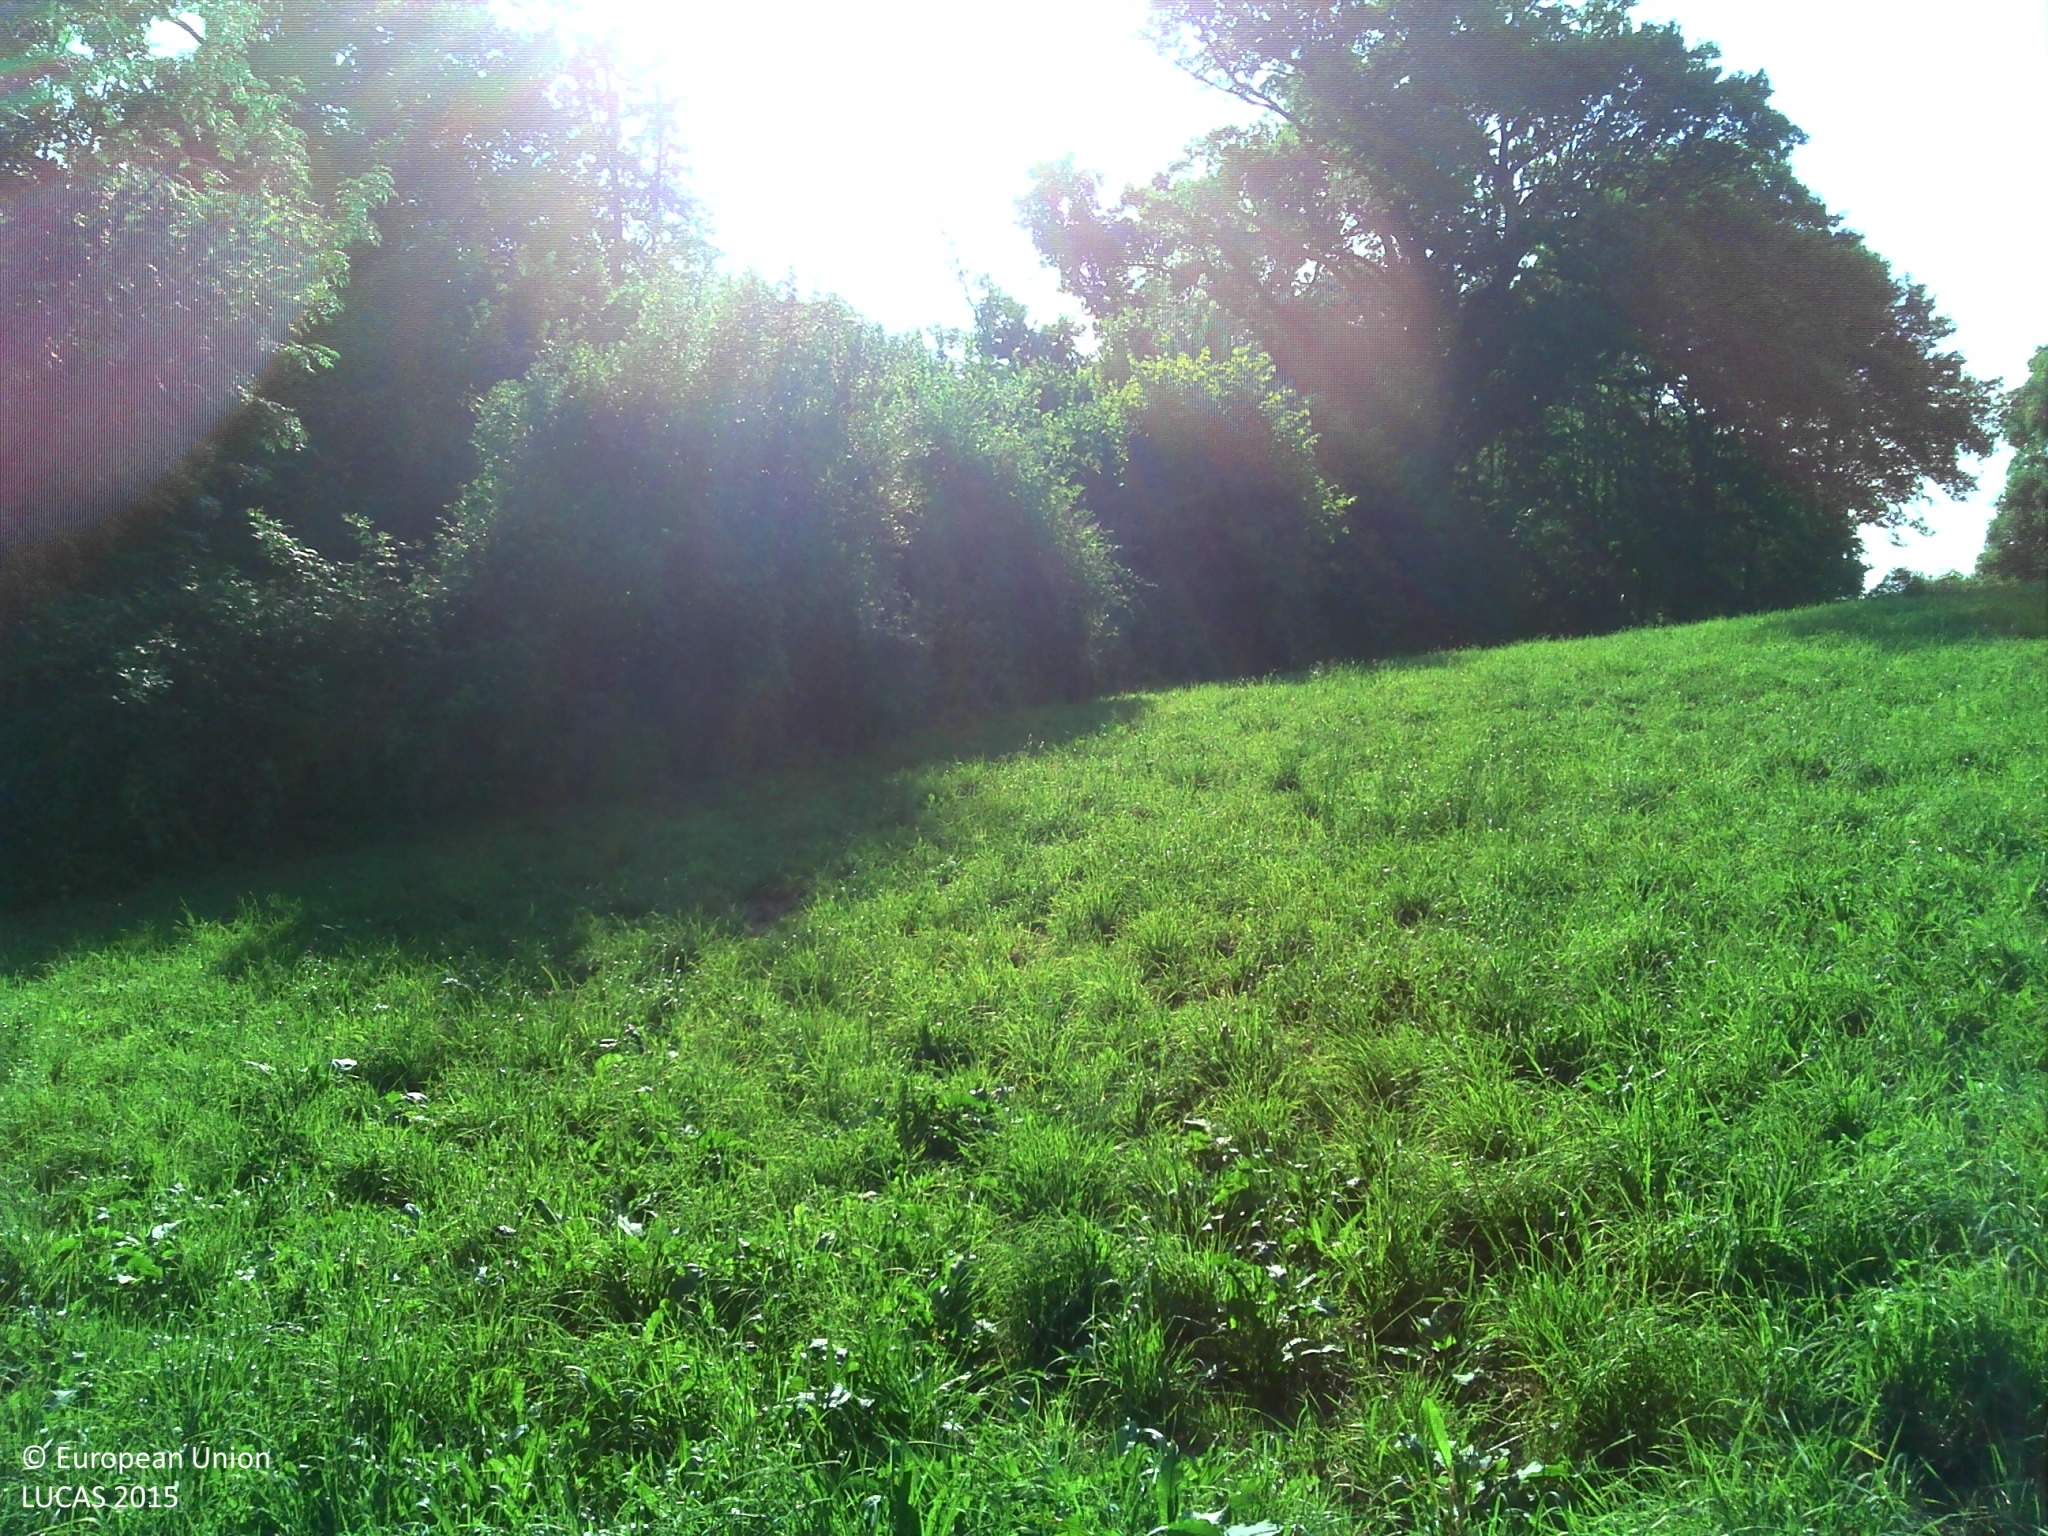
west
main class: Grassland
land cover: Grassland without tree/shrub cover
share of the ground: > 75 %
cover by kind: herbaceous plants 100 %
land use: Agriculture (excluding fallow land and kitchen gardens)
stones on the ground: < 10 %
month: June
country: FR
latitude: 45.7207
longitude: 0.6207
